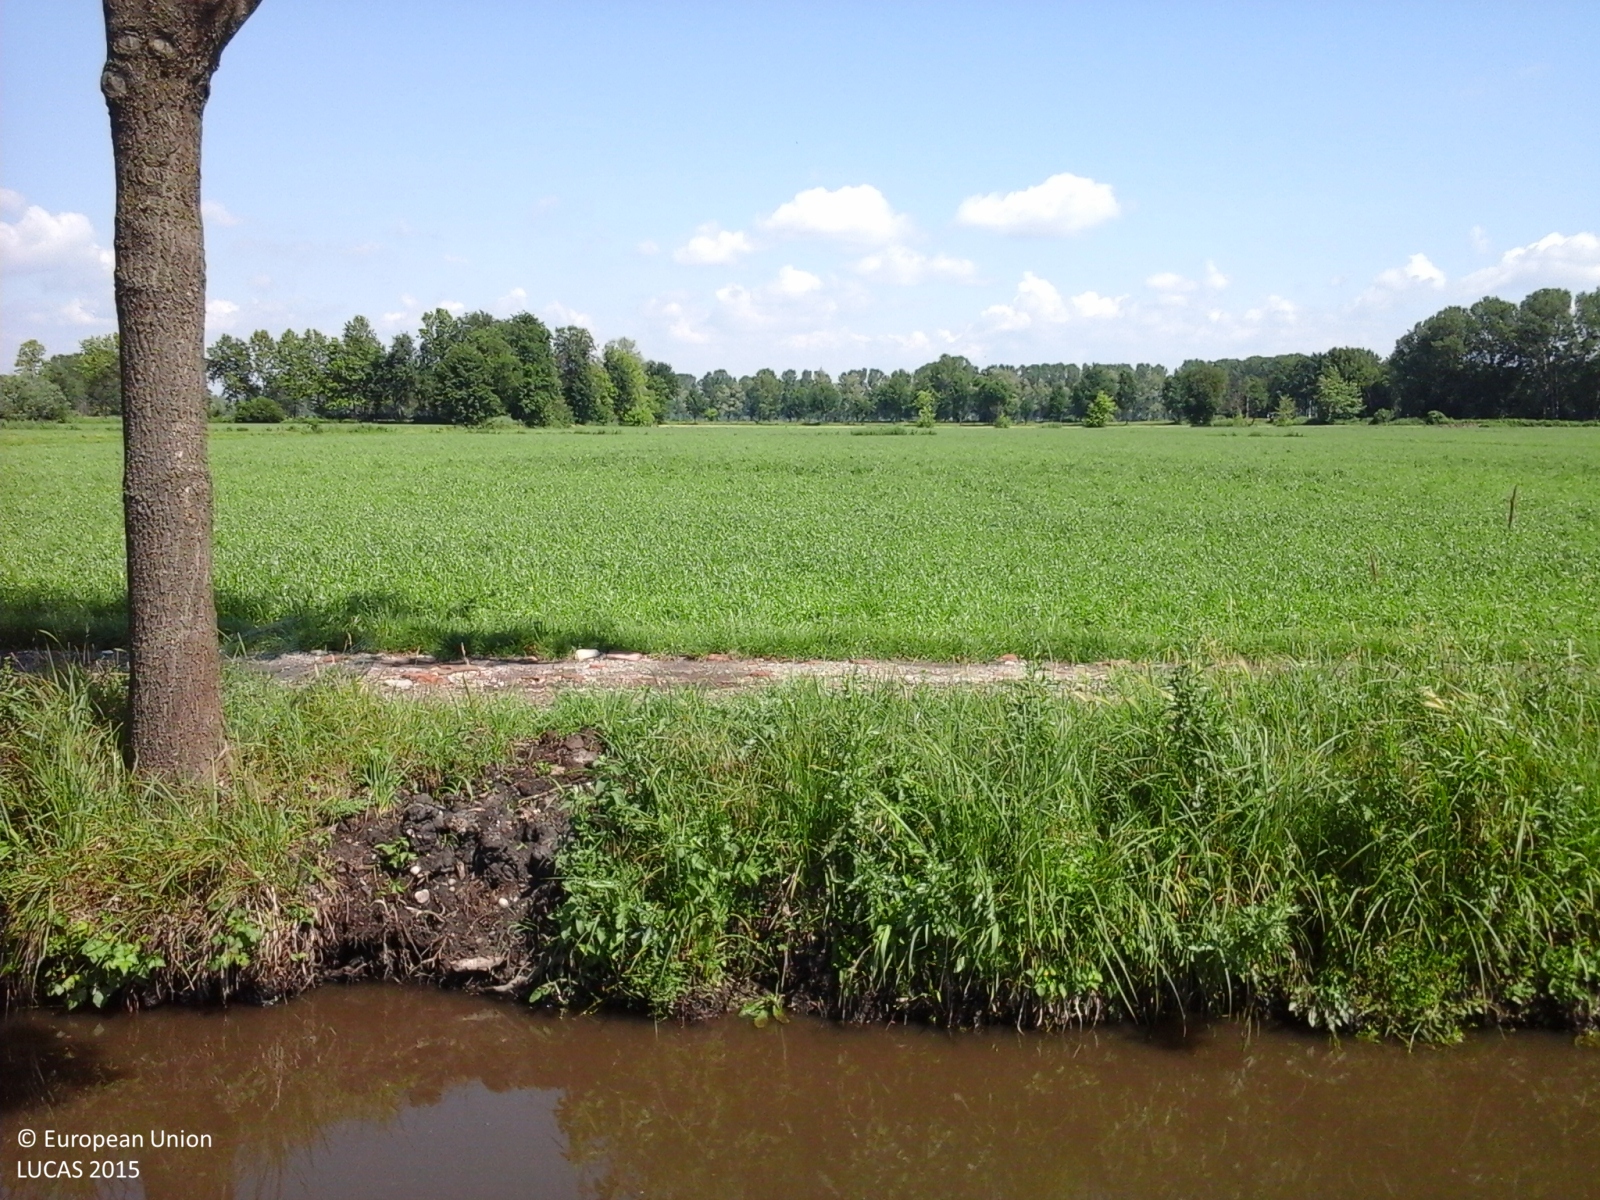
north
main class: Cropland
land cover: Maize
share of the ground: > 75 %
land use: Agriculture (excluding fallow land and kitchen gardens)
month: May
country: IT
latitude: 45.3775
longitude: 9.6048
